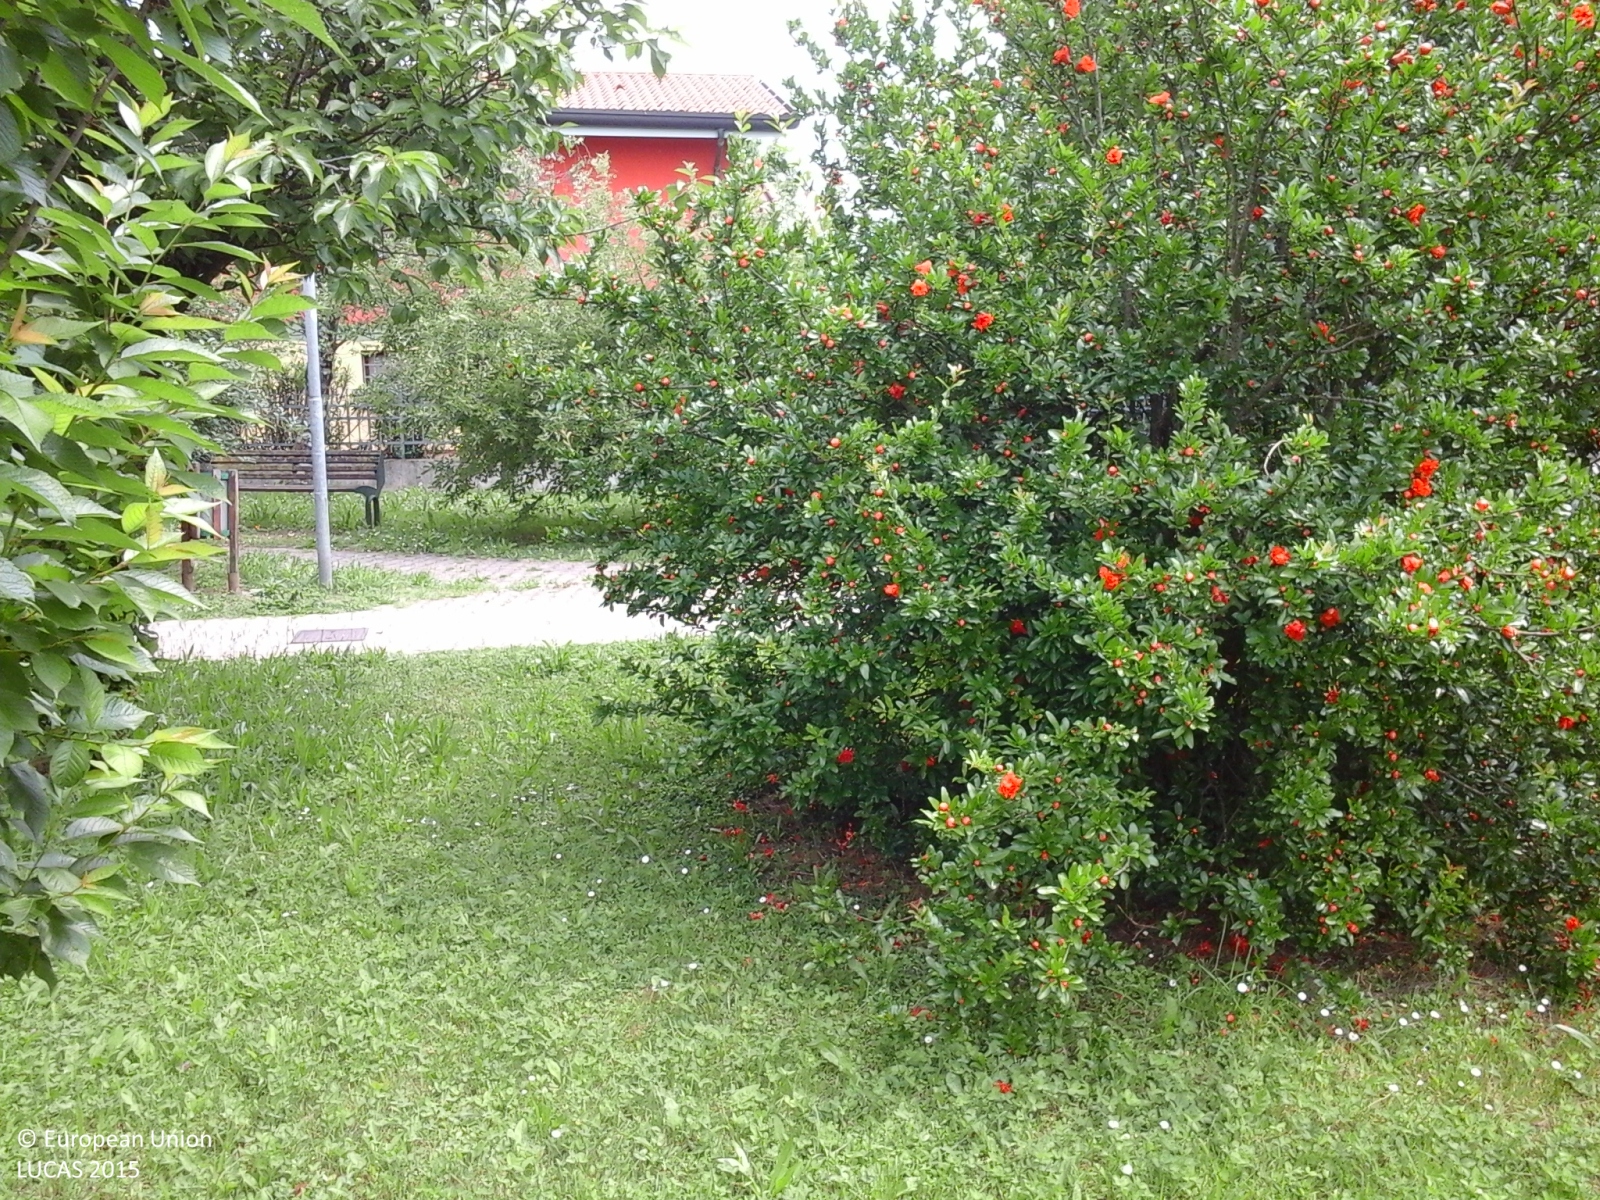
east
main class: Woodland
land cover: Broadleaved woodland
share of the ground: > 75 %
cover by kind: herbaceous plants 75 %, broadleaved forest trees 15 %, shrubs 10 %
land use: Amenities, museums, leisure
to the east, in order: Broadleaved woodland; Artificial constructions in urban areas
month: June
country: IT
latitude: 45.6418
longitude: 12.2932
